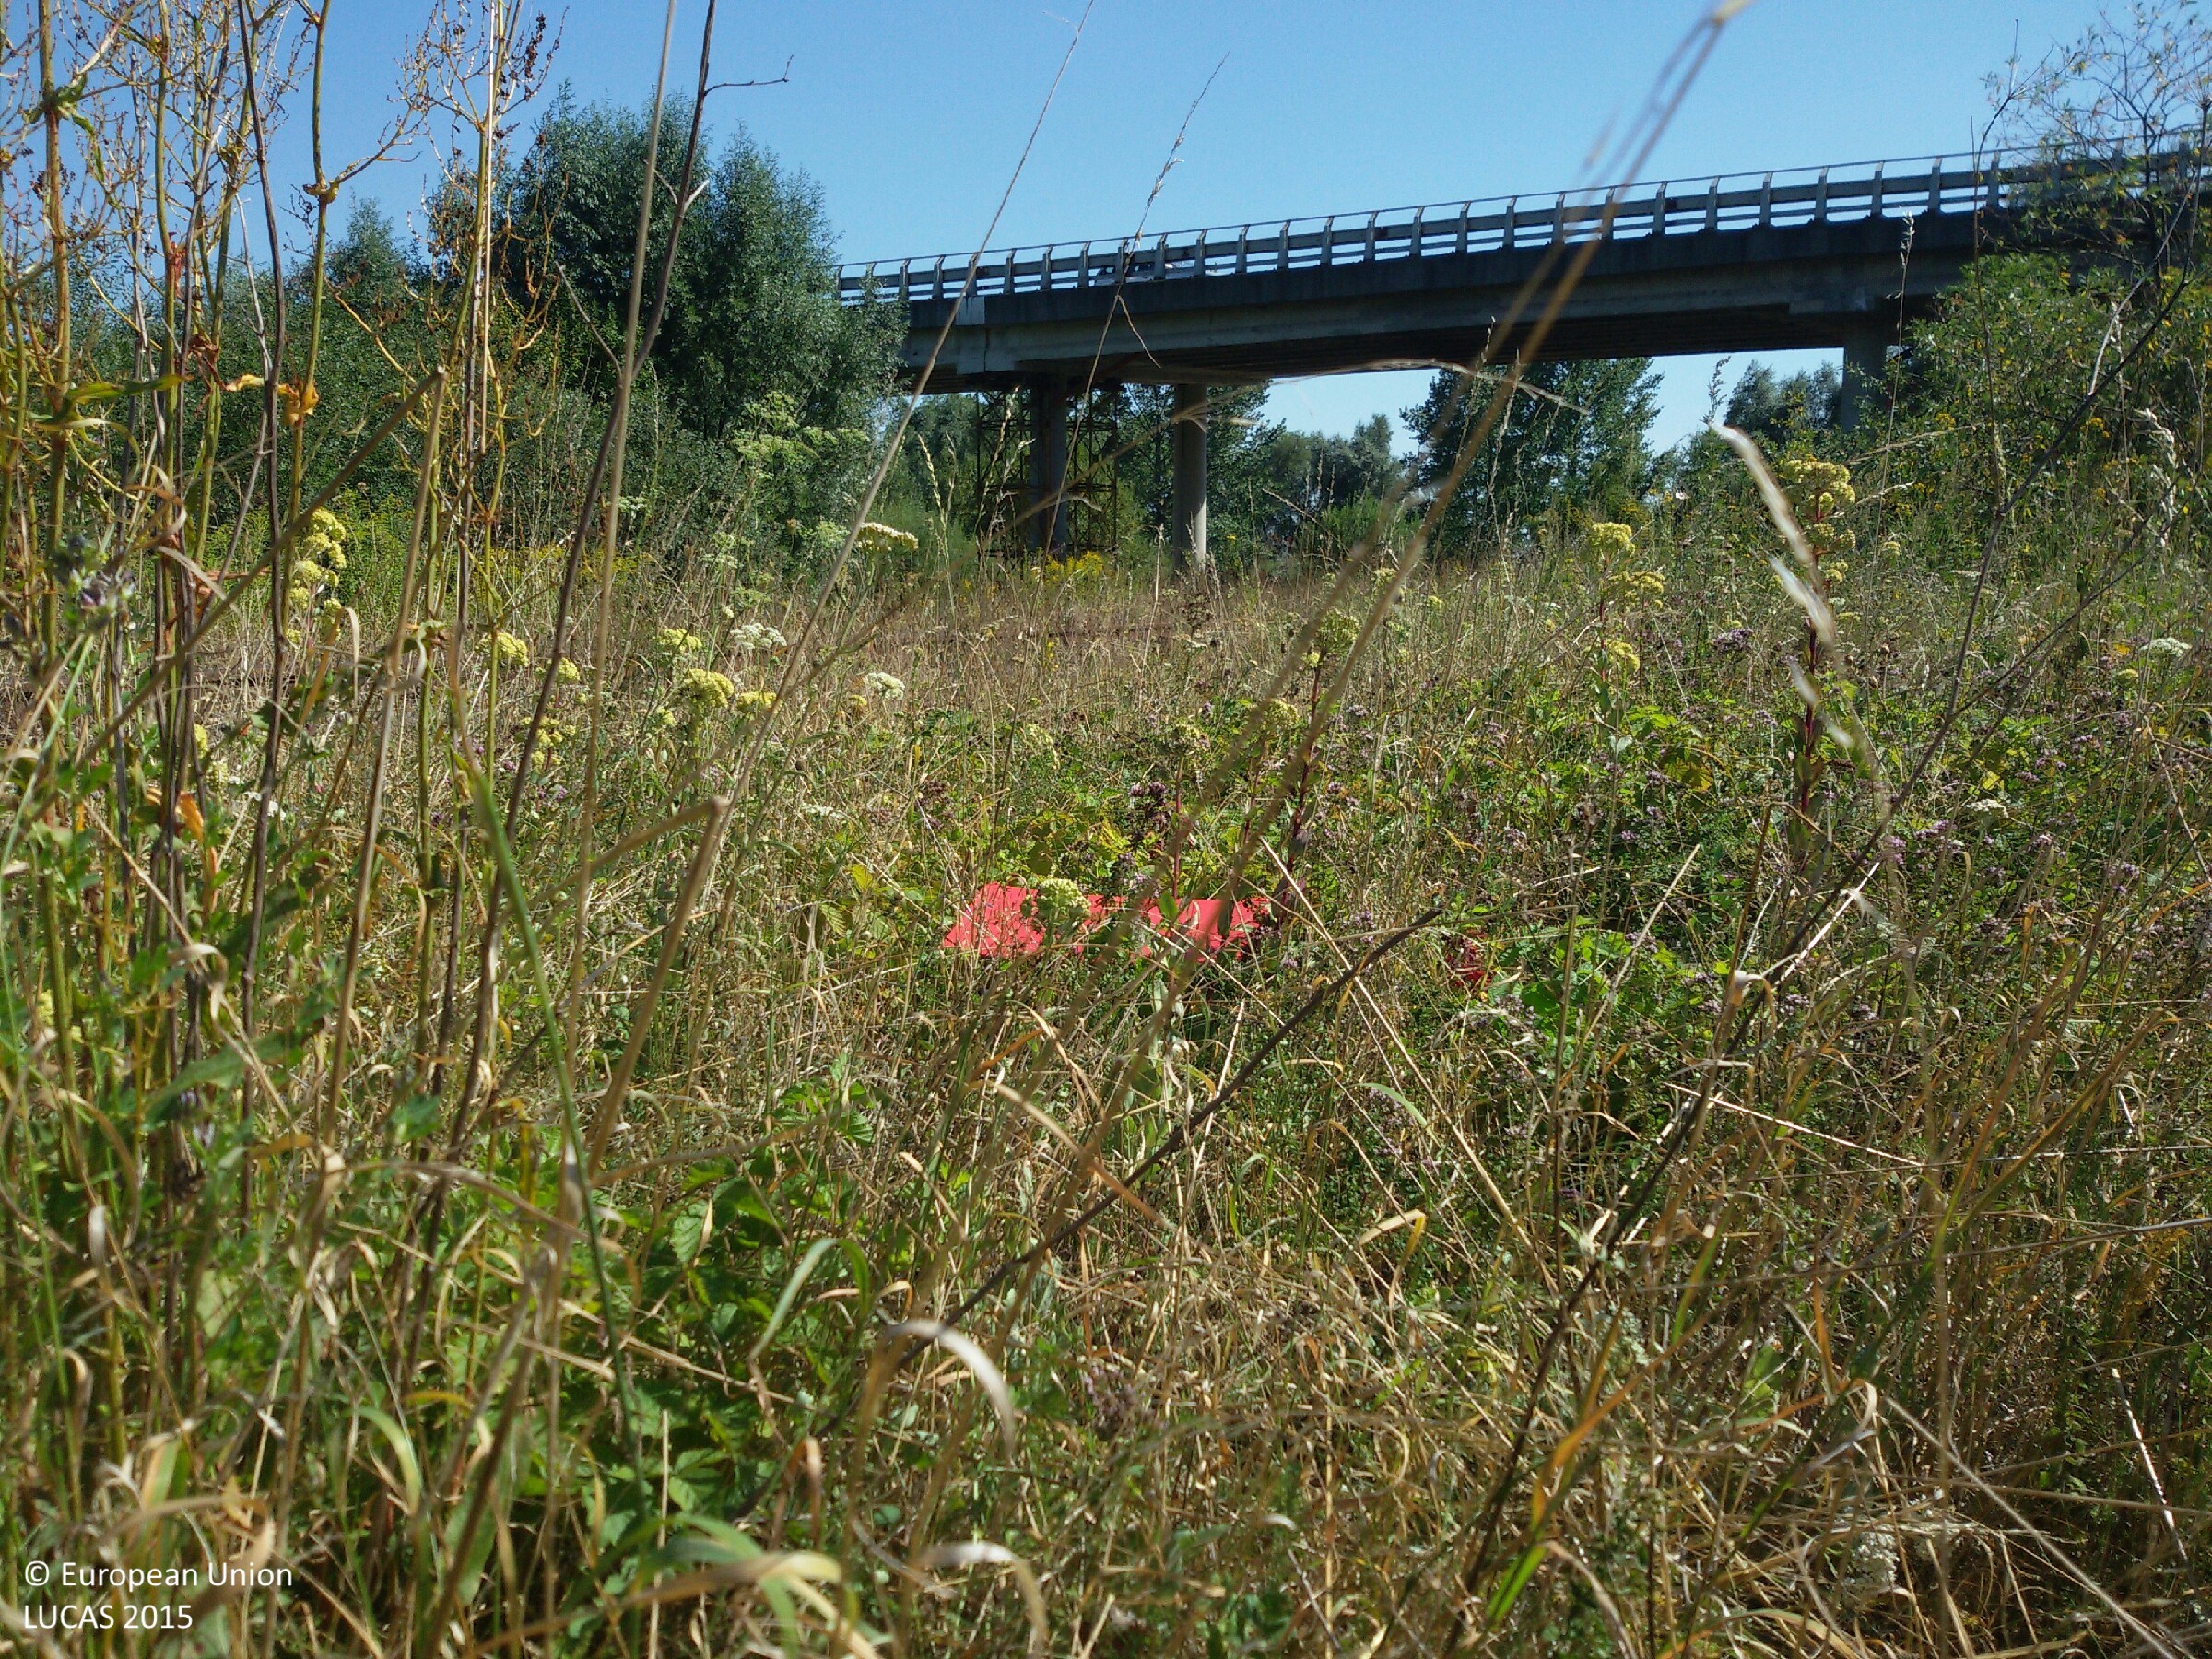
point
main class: Grassland
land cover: Spontaneously vegetated surfaces
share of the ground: > 75 %
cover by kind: herbaceous plants 95 %, shrubs 5 %
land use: Semi-natural and natural areas not in use
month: August
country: PL
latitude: 54.1417
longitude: 19.3777
